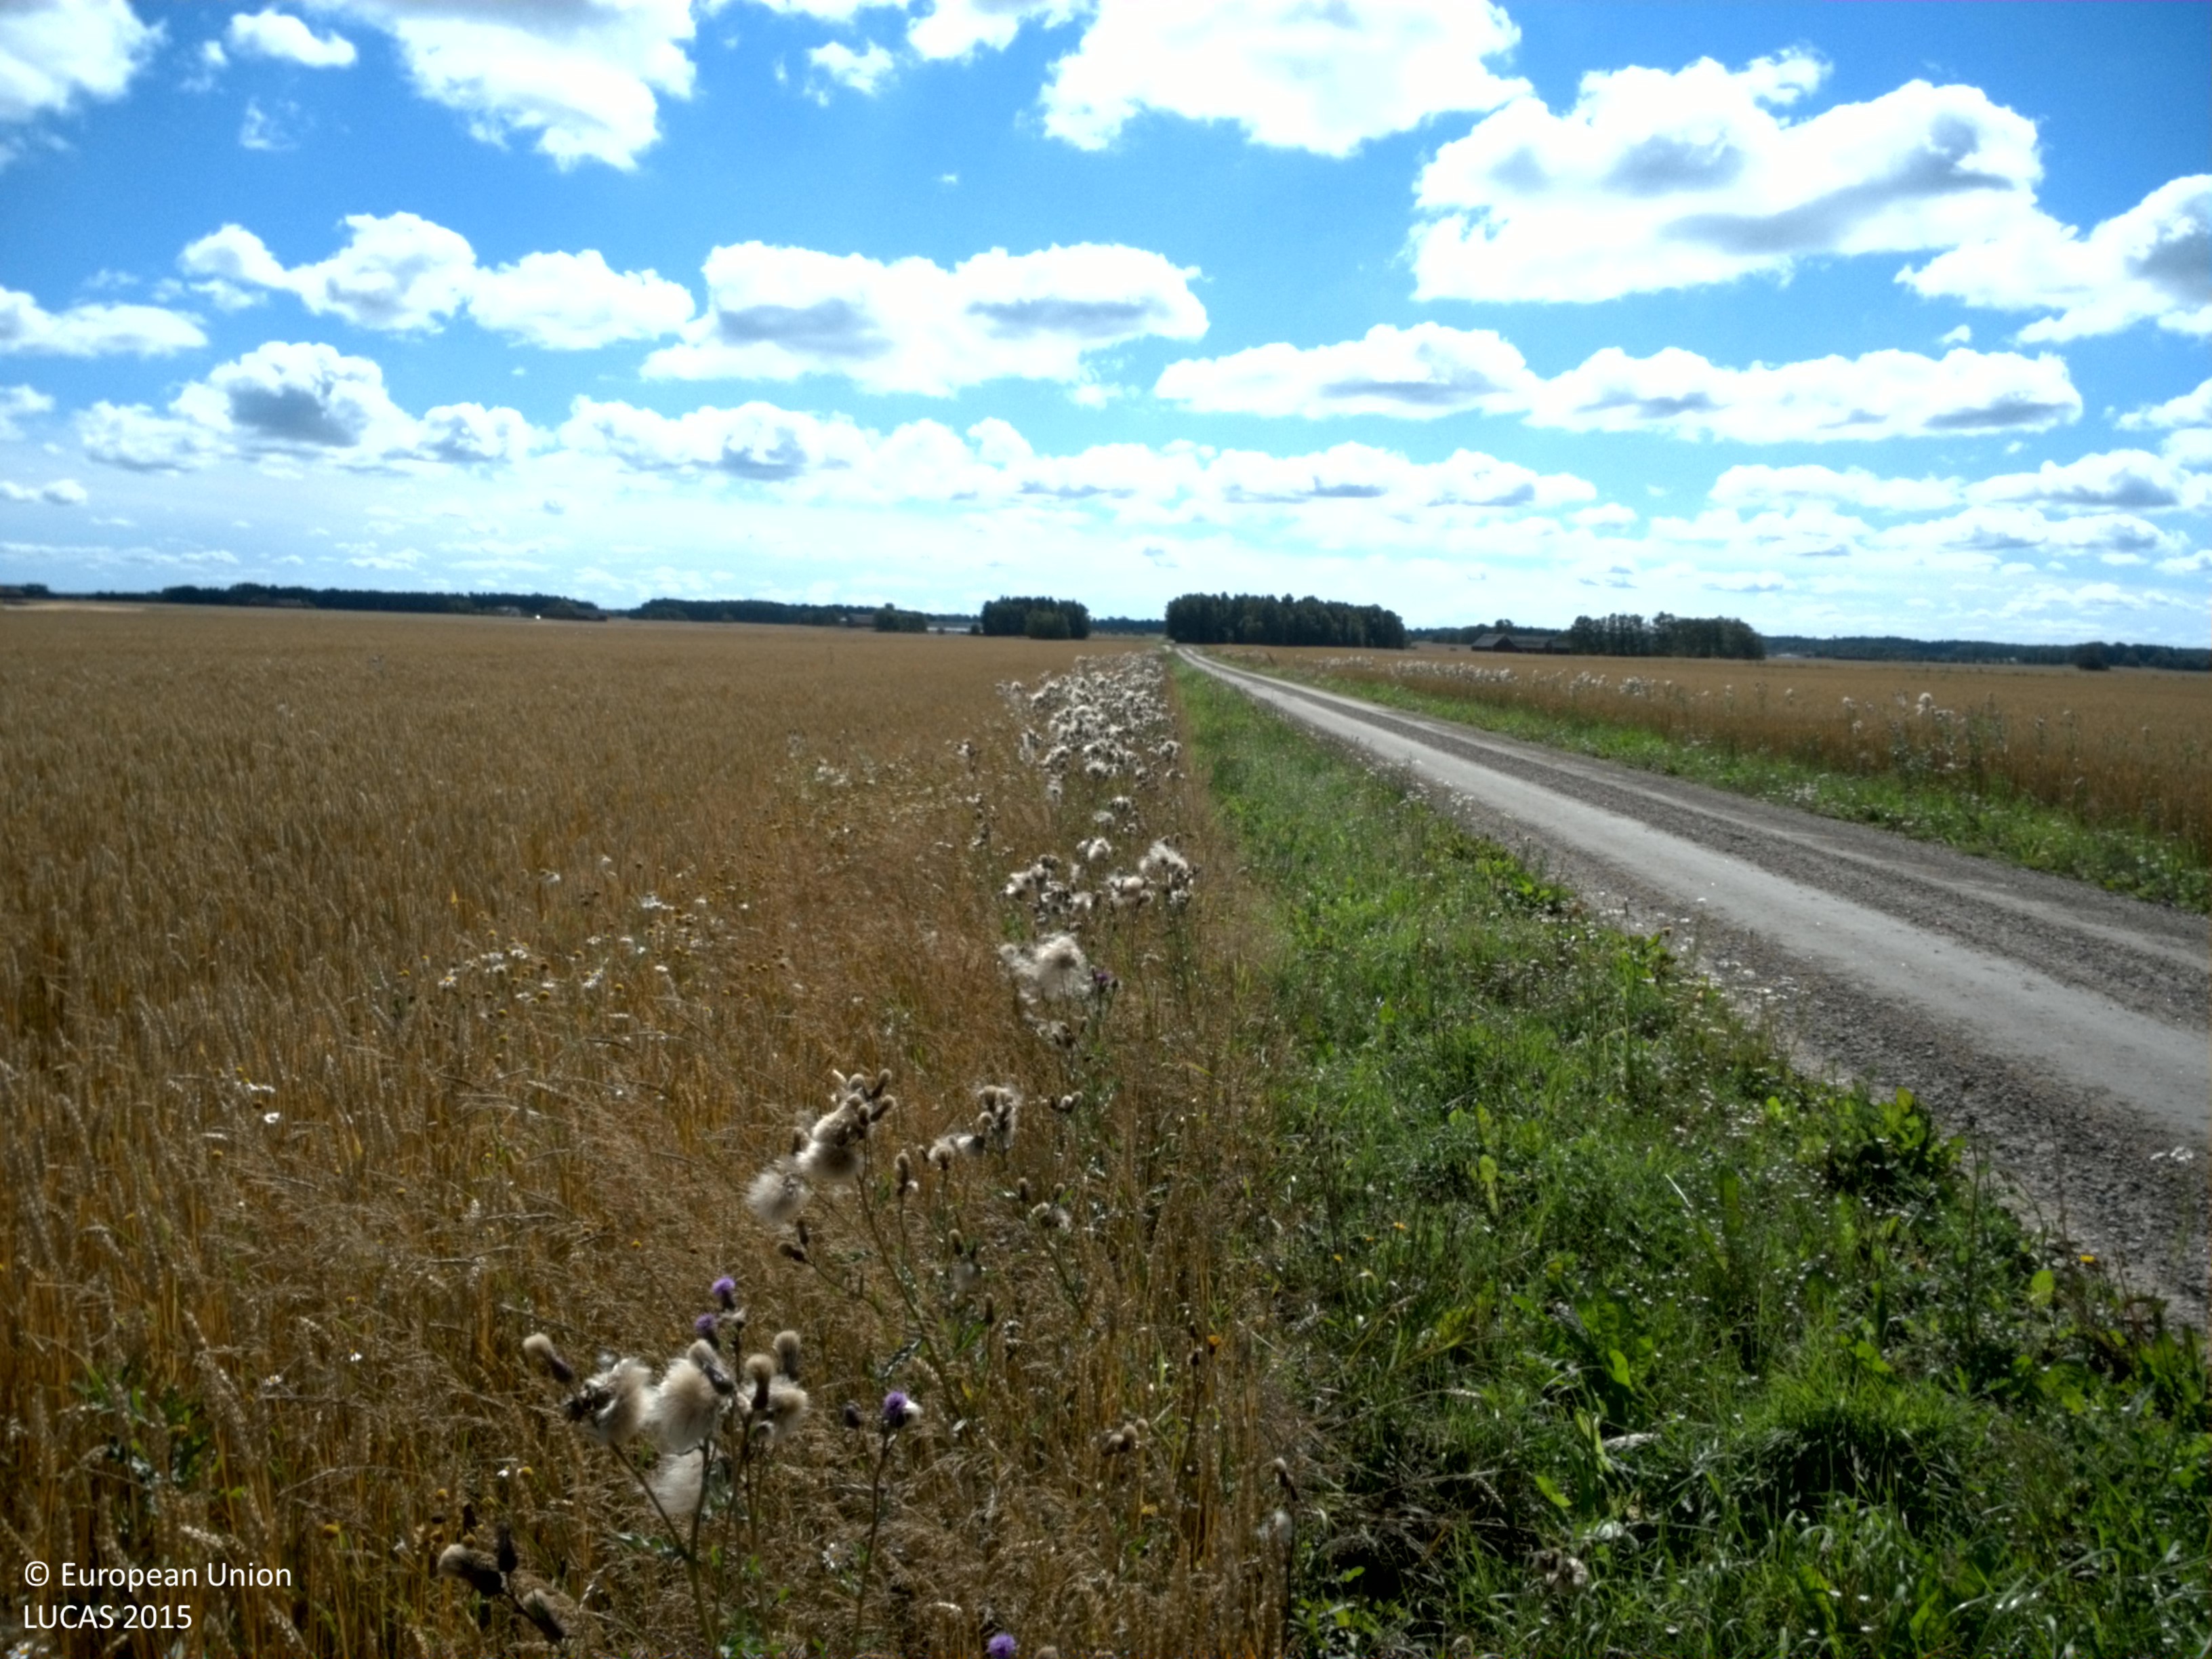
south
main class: Cropland
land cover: Common wheat
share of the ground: > 75 %
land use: Agriculture (excluding fallow land and kitchen gardens)
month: August
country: SE
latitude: 58.2711
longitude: 13.2166
